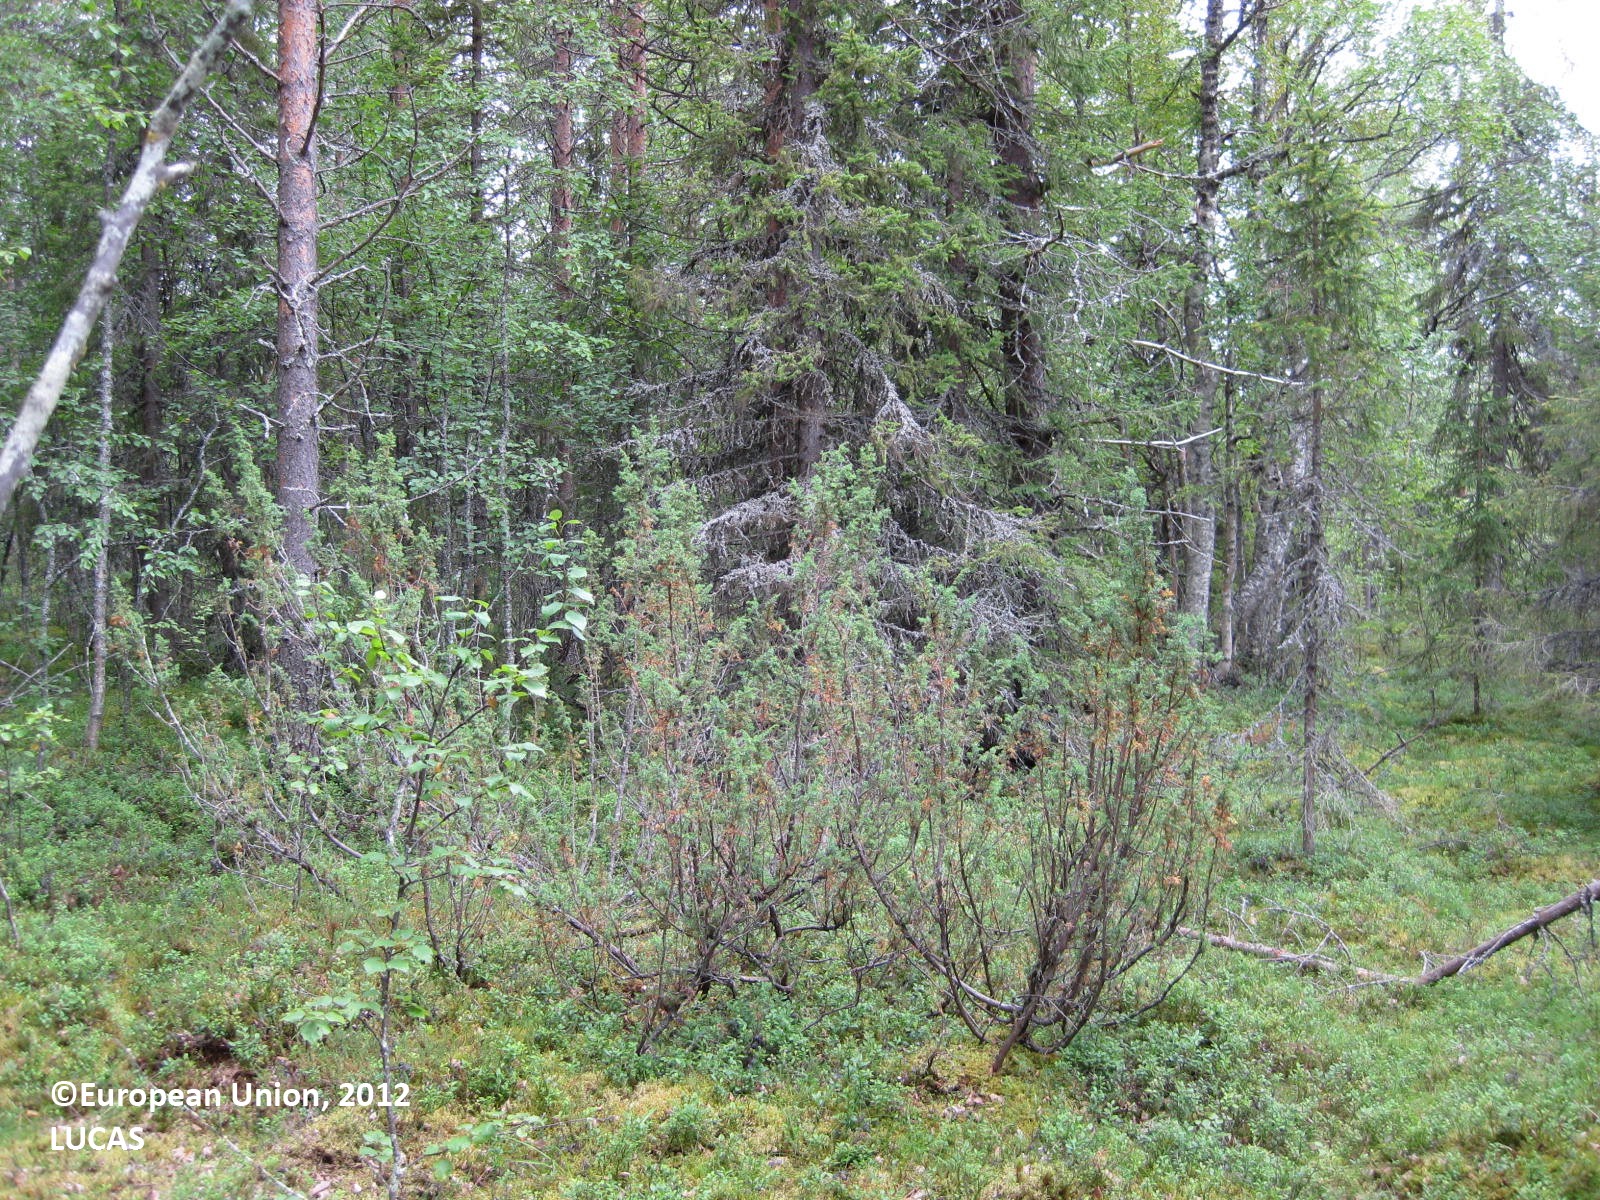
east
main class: Woodland
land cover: Other mixed woodland
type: boreal forest
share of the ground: > 75 %
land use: Forestry
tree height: > 5 m
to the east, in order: Other mixed woodland; Tracks; Pine dominated mixed woodland; Ditches and canals; Pine dominated mixed woodland; Ditches and canals; Pine dominated mixed woodland; Ditches and canals; Pine dominated mixed woodland; Ditches and canals; Pine dominated mixed woodland; Ditches and canals; Pine dominated mixed woodland; Ditches and canals; Pine dominated mixed woodland; Ditches and canals; Pine dominated mixed woodland; Ditches and canals; Pine dominated mixed woodland
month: August
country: FI
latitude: 66.3839
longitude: 28.4676
